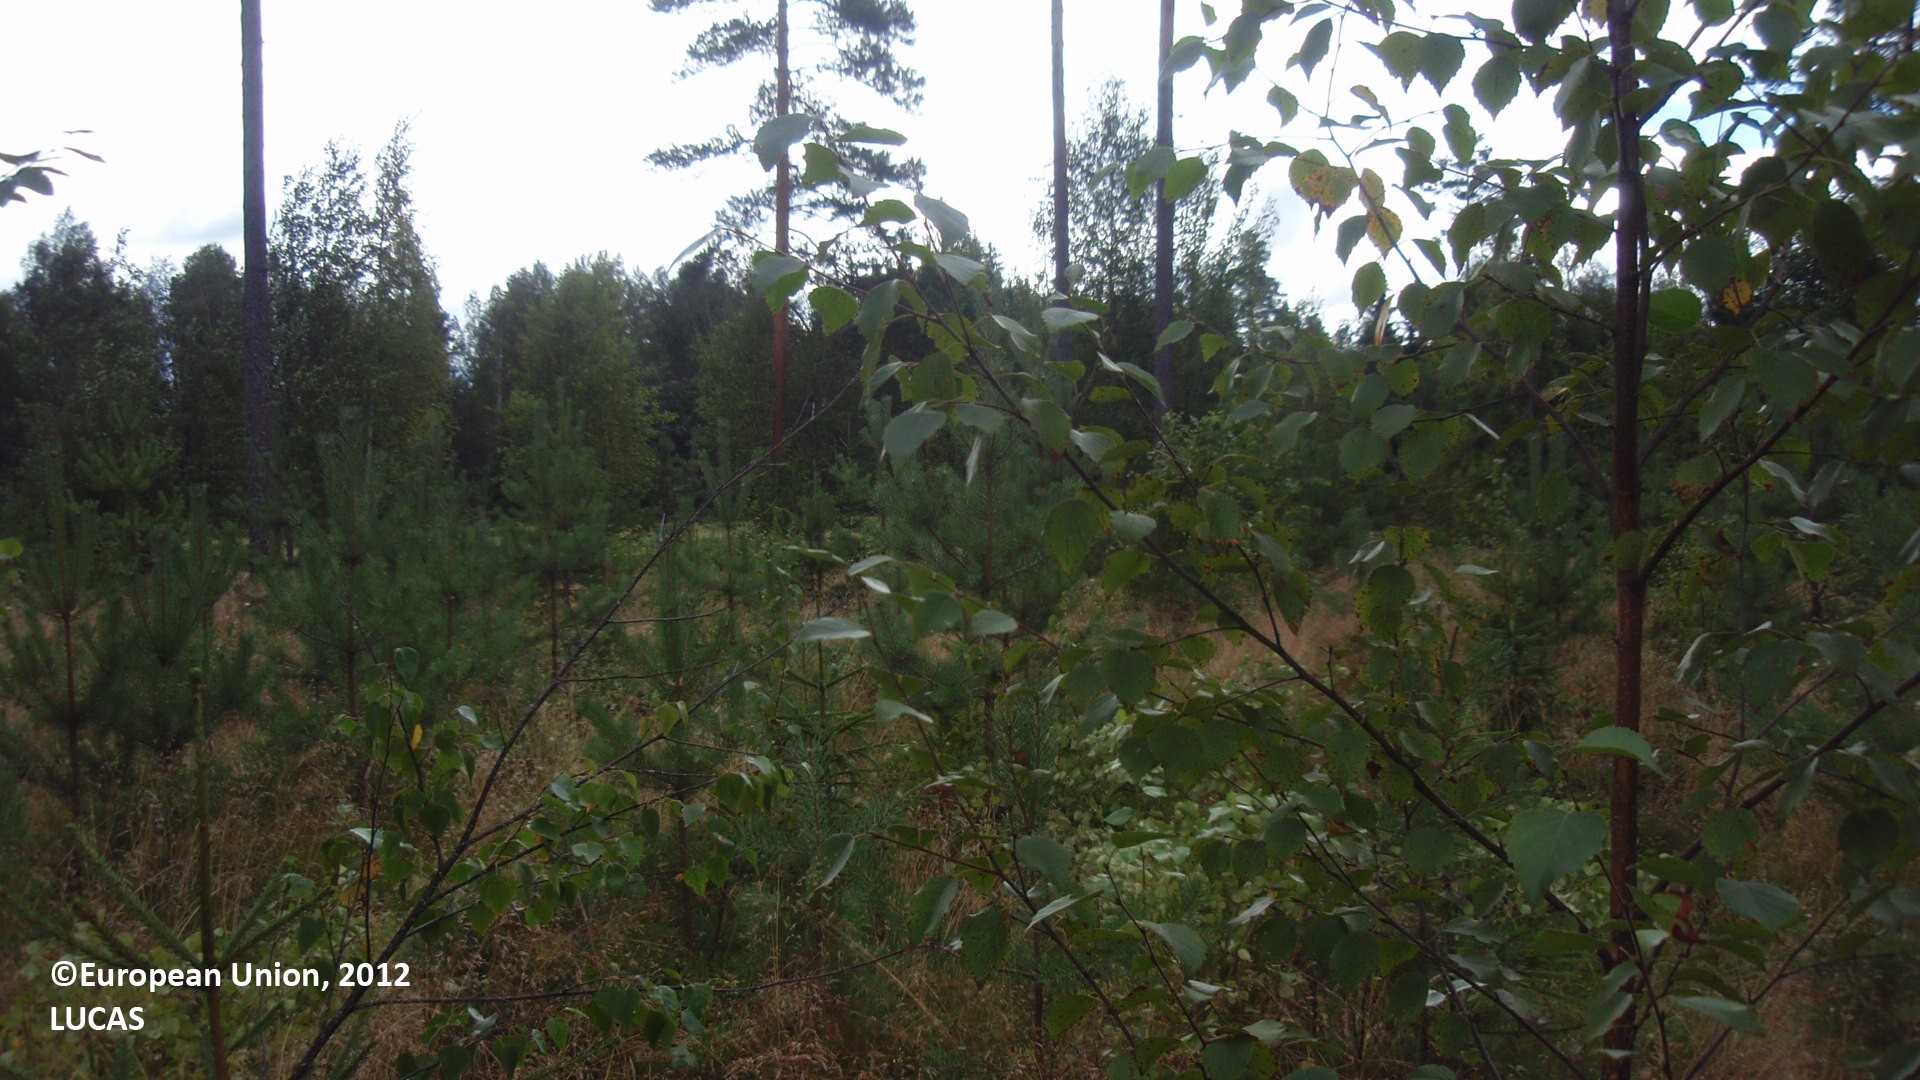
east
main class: Grassland
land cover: Grassland with sparse tree/shrub cover
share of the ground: 25 - 50 %
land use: Forestry
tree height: < 5 m
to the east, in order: Grassland with sparse tree/shrub cover; Ditches and canals; Common wheat; Ditches and canals; Broadleaved woodland; Shrubland with sparse tree cover
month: August
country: FI
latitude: 61.0853
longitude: 27.4025
